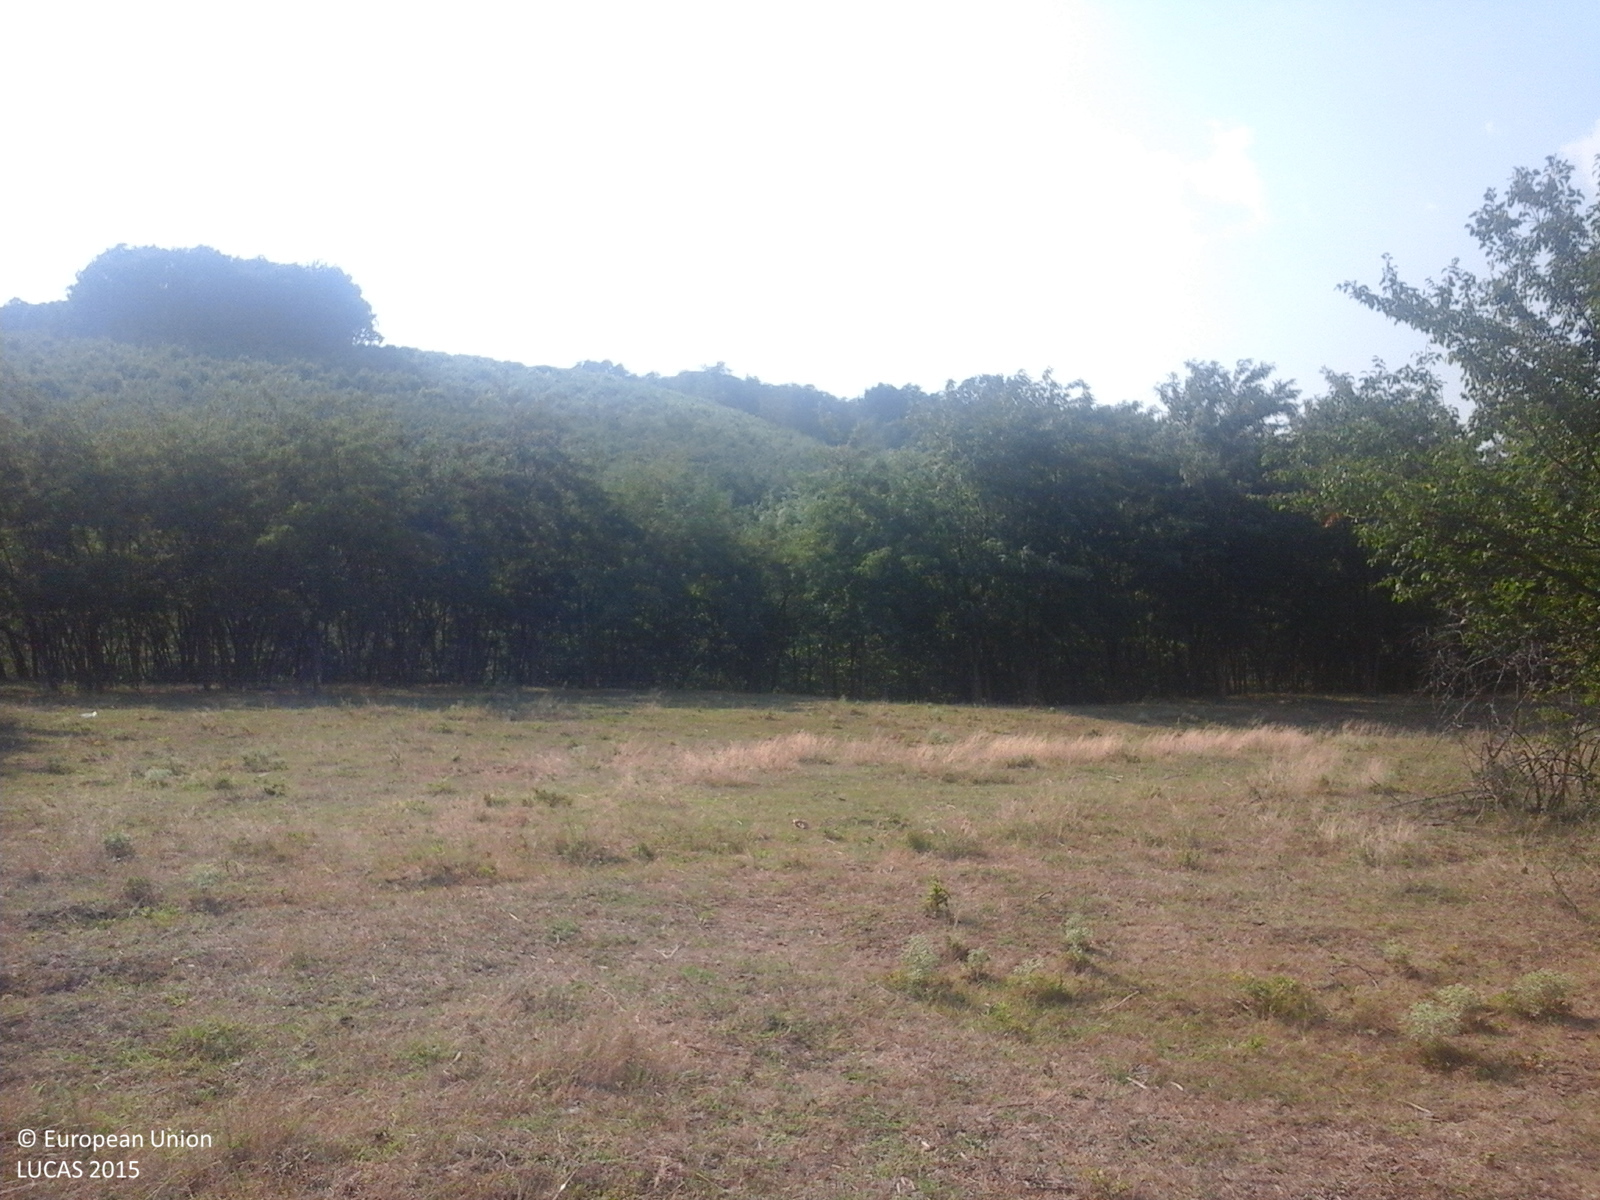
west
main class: Grassland
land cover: Grassland with sparse tree/shrub cover
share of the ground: > 75 %
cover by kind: herbaceous plants 95 %, broadleaved forest trees 5 %
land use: Agriculture (excluding fallow land and kitchen gardens)
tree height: > 5 m
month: July
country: RO
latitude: 46.1002
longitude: 27.7733
